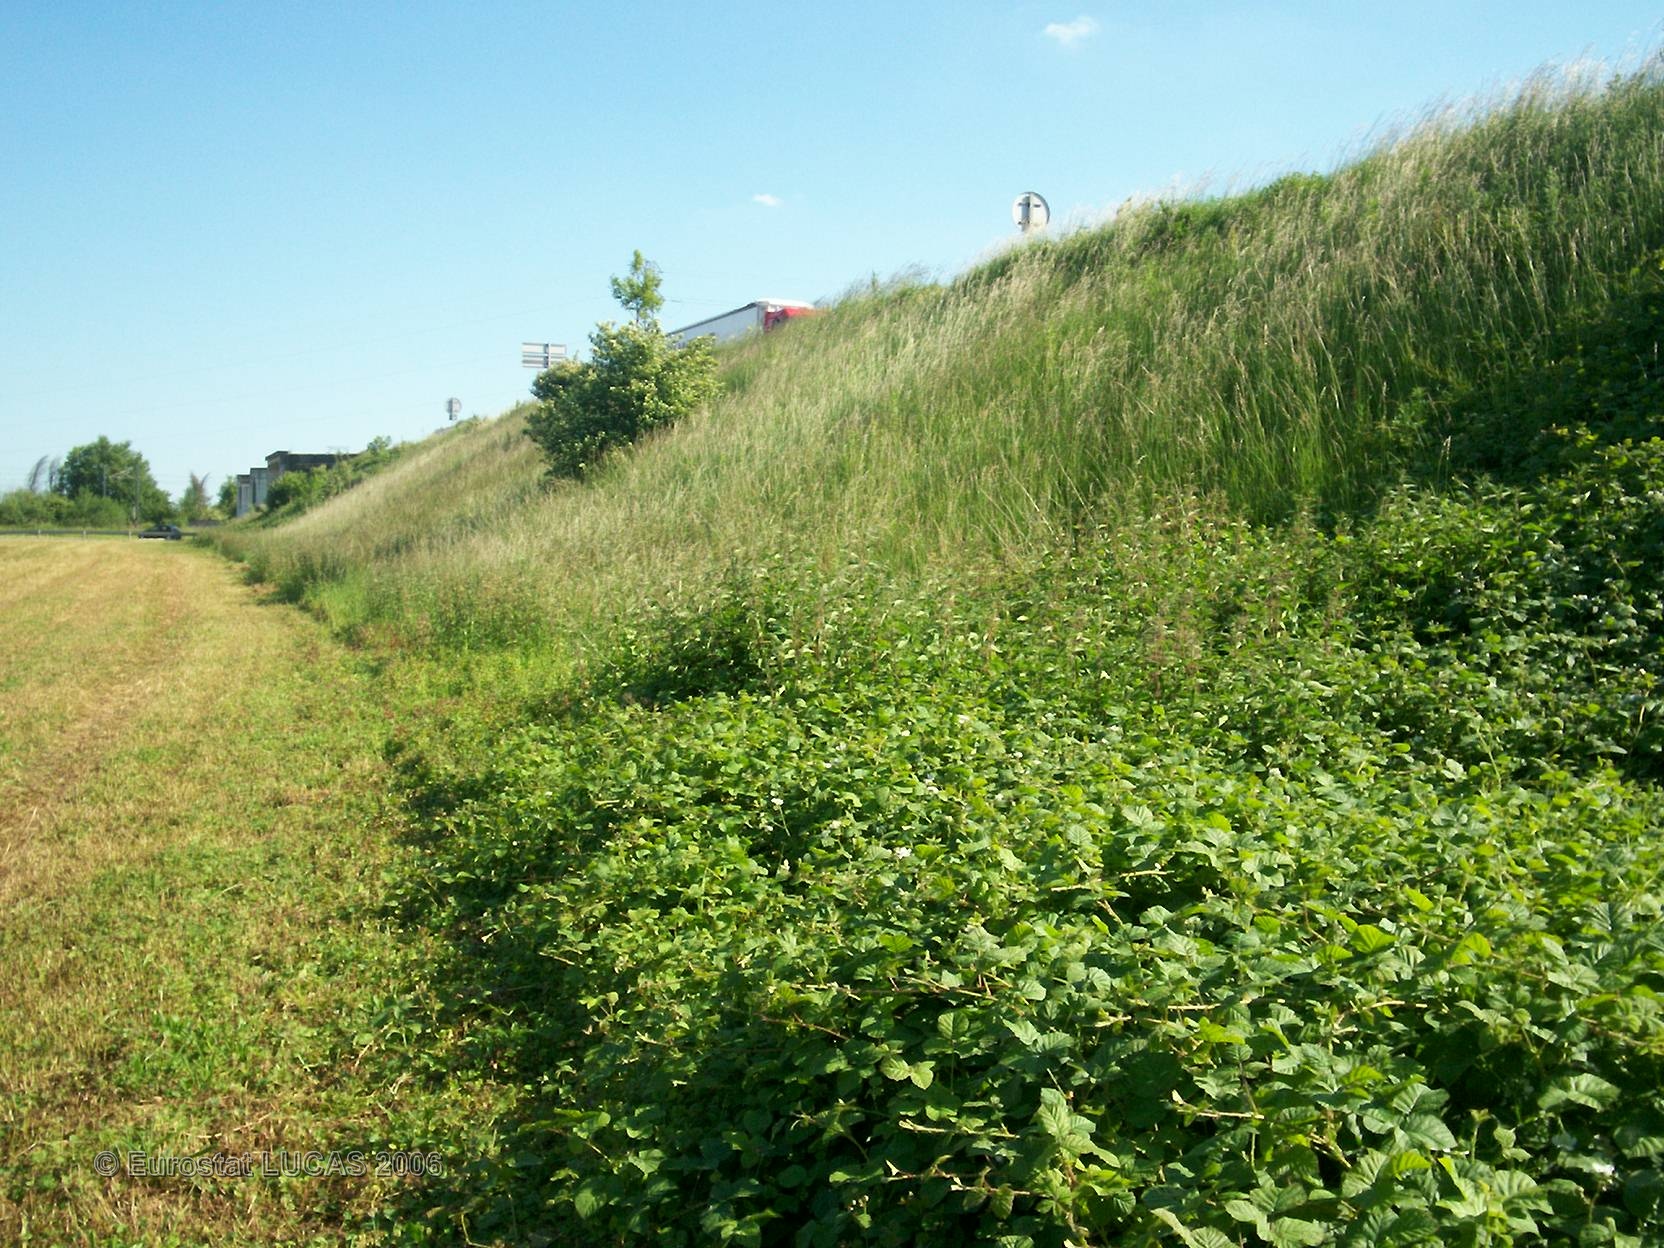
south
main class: Cropland
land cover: Lucerne
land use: Agriculture (excluding fallow land and kitchen gardens)
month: June
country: FR
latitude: 48.7237
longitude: 4.6278
